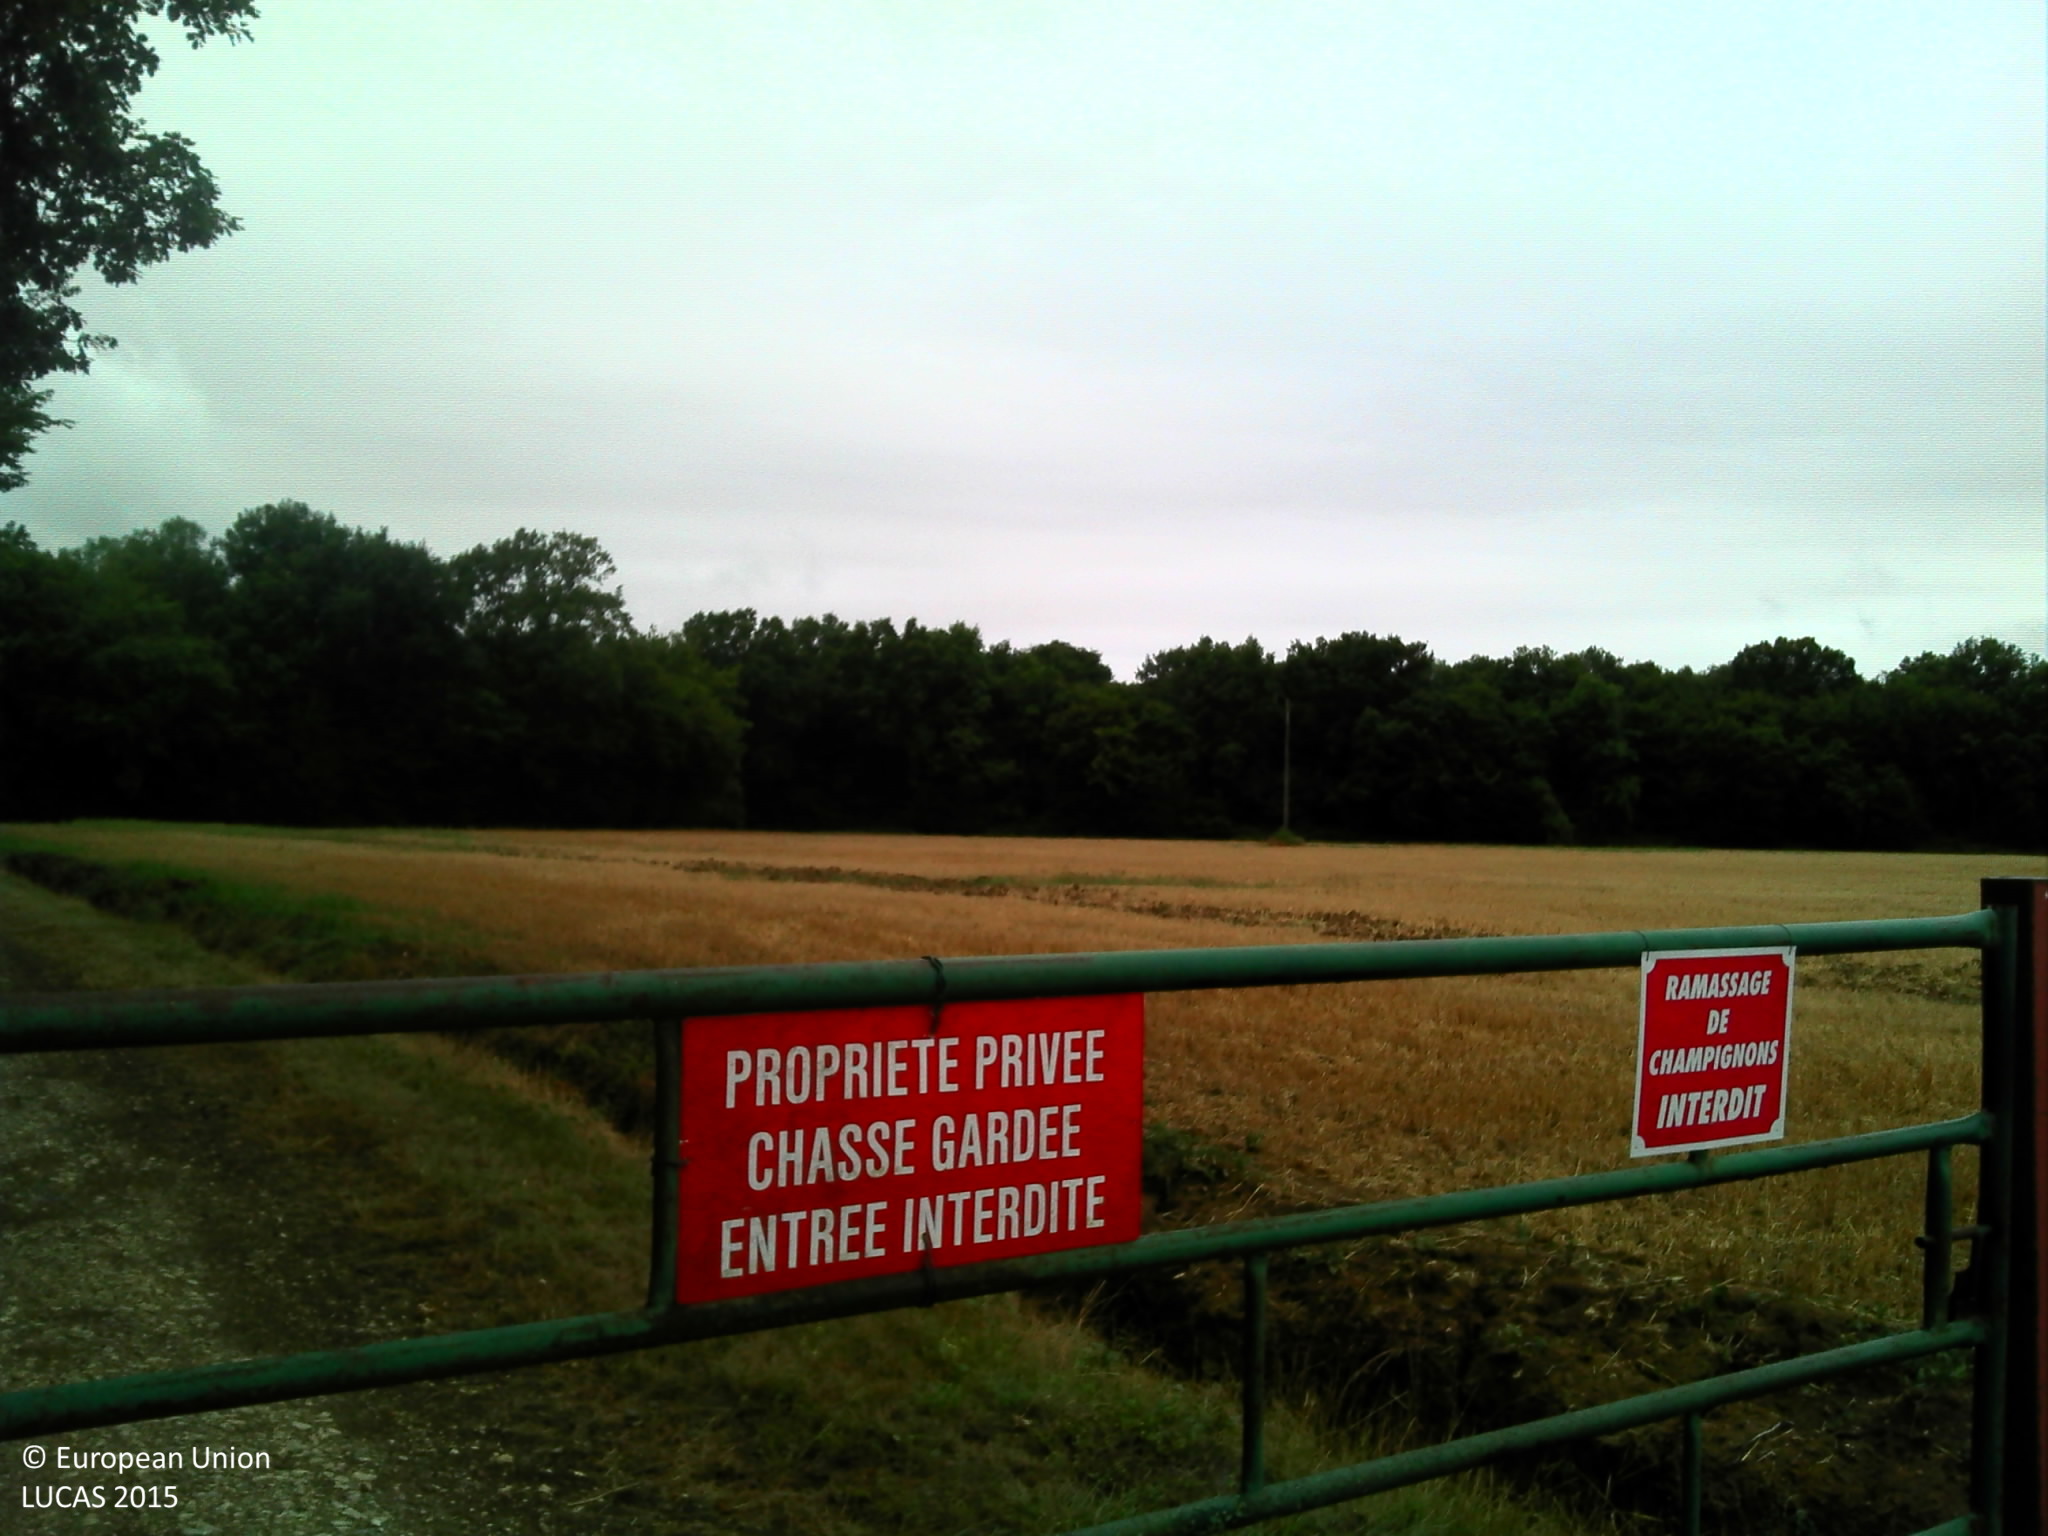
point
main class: Woodland
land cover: Broadleaved woodland
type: mesophytic deciduous forest
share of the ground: > 75 %
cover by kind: broadleaved forest trees 100 %
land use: Forestry
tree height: > 5 m
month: July
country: FR
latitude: 46.8573
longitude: 2.1354
